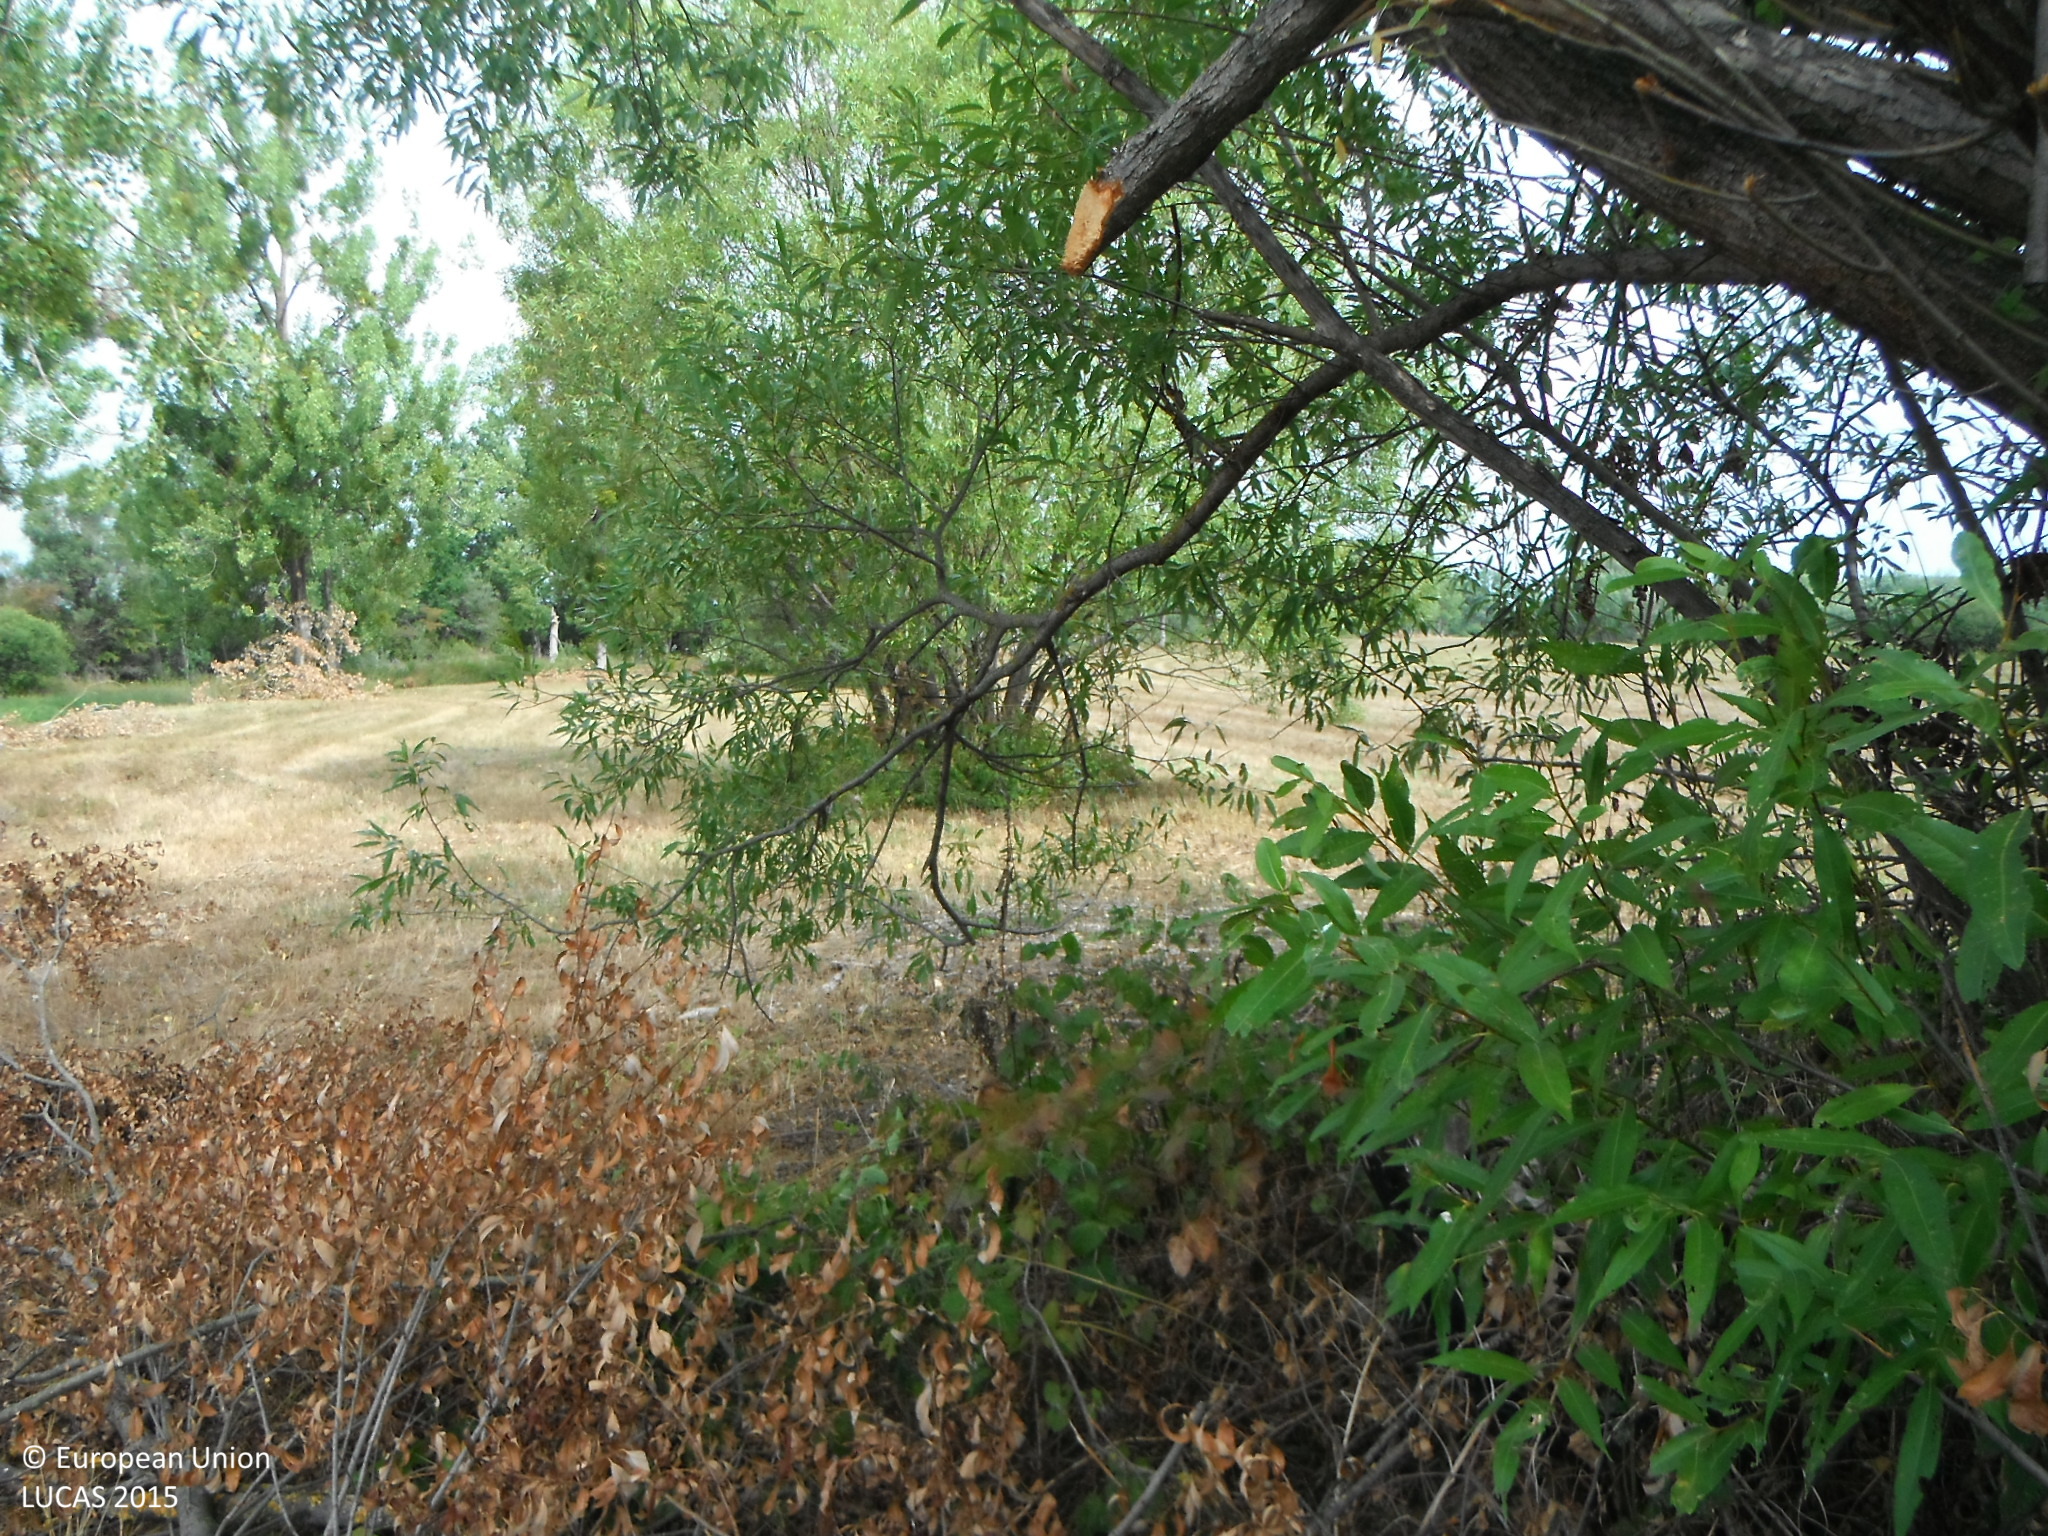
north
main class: Grassland
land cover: Grassland with sparse tree/shrub cover
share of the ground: > 75 %
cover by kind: herbaceous plants 90 %, broadleaved forest trees 5 %, shrubs 5 %
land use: Agriculture (excluding fallow land and kitchen gardens)
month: August
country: SK
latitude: 48.4924
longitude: 21.8378
